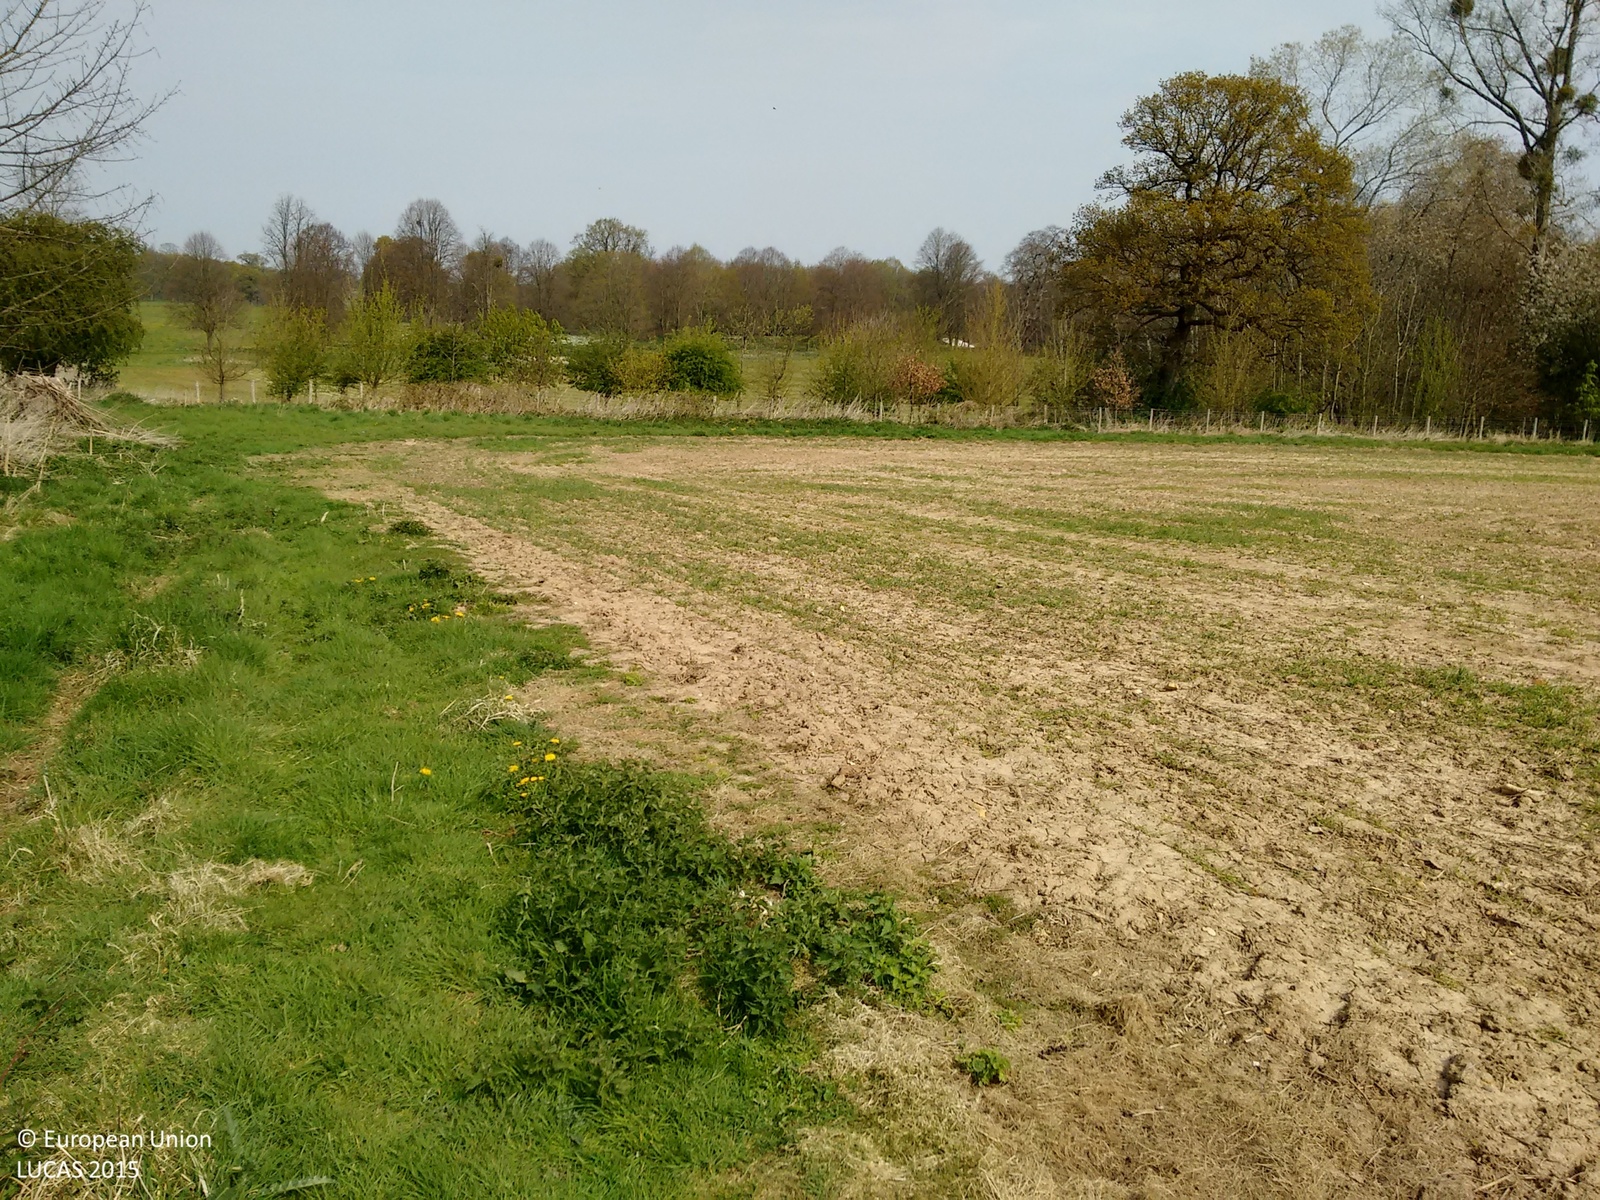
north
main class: Cropland
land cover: Common wheat
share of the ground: 25 - 50 %
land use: Agriculture (excluding fallow land and kitchen gardens)
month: April
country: GB
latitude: 51.3912
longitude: 0.4144
